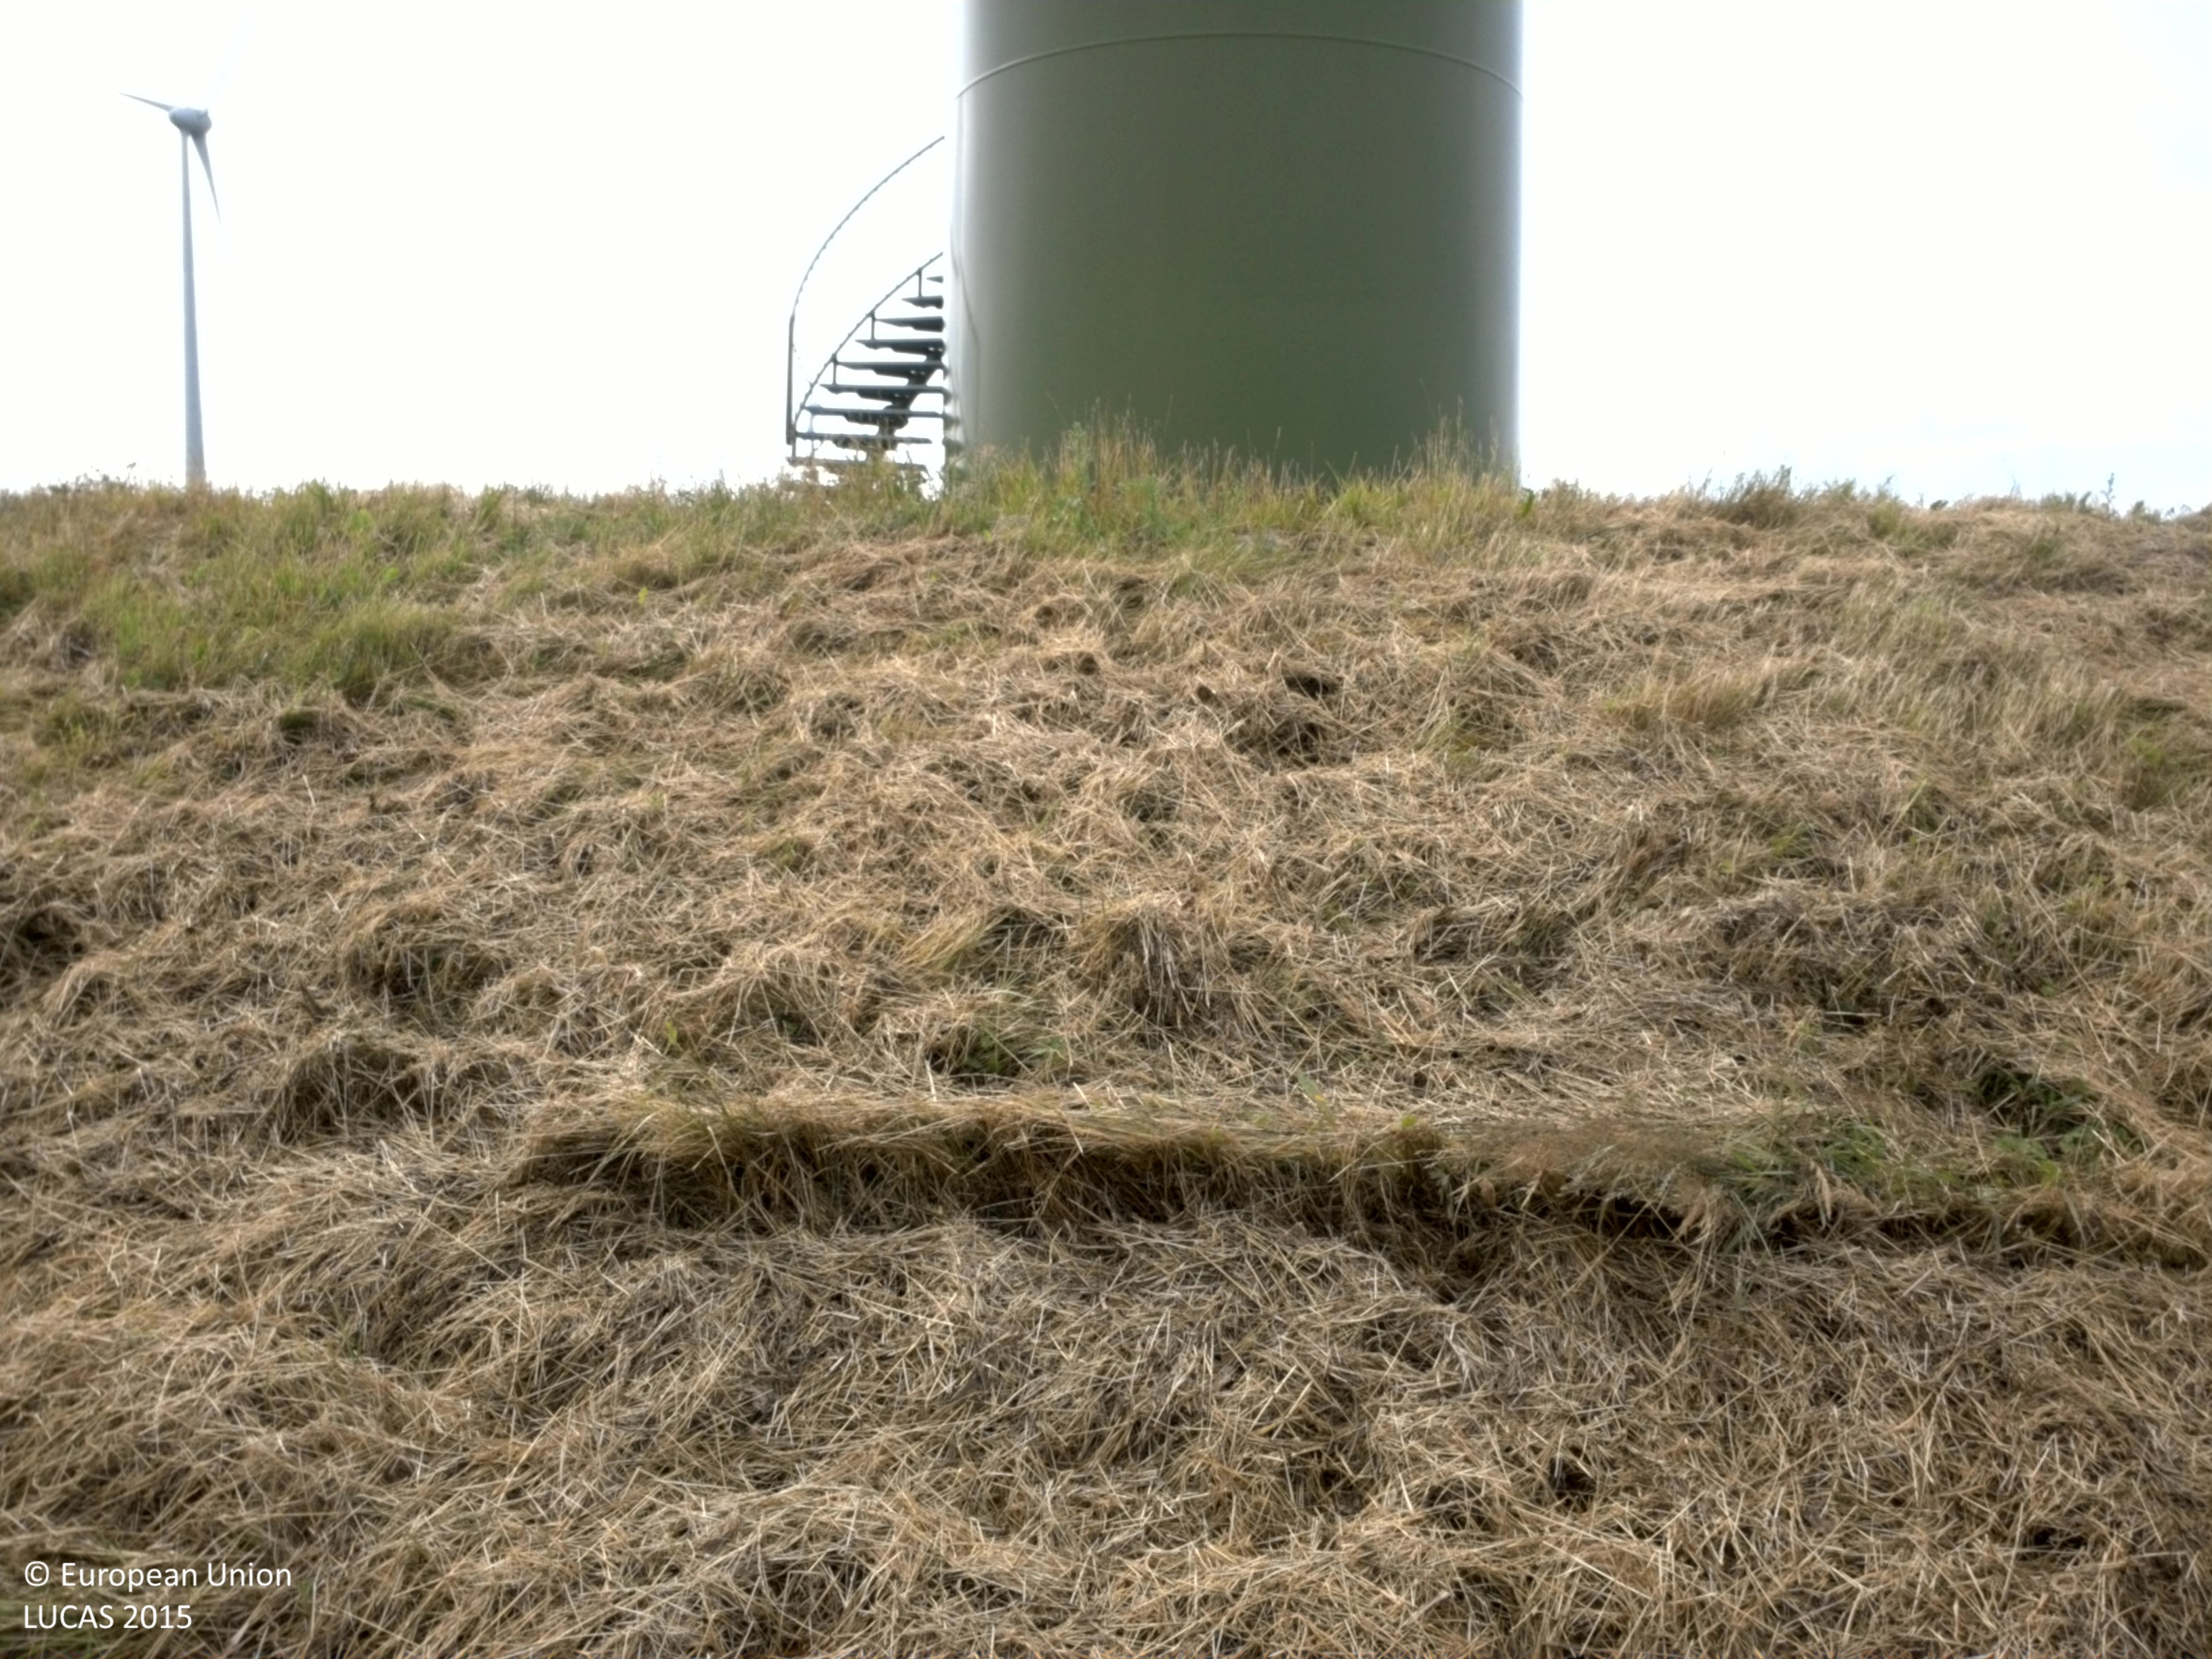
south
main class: Cropland
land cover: Oats
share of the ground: > 75 %
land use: Agriculture (excluding fallow land and kitchen gardens)
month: July
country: SE
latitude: 58.5013
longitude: 13.3744
